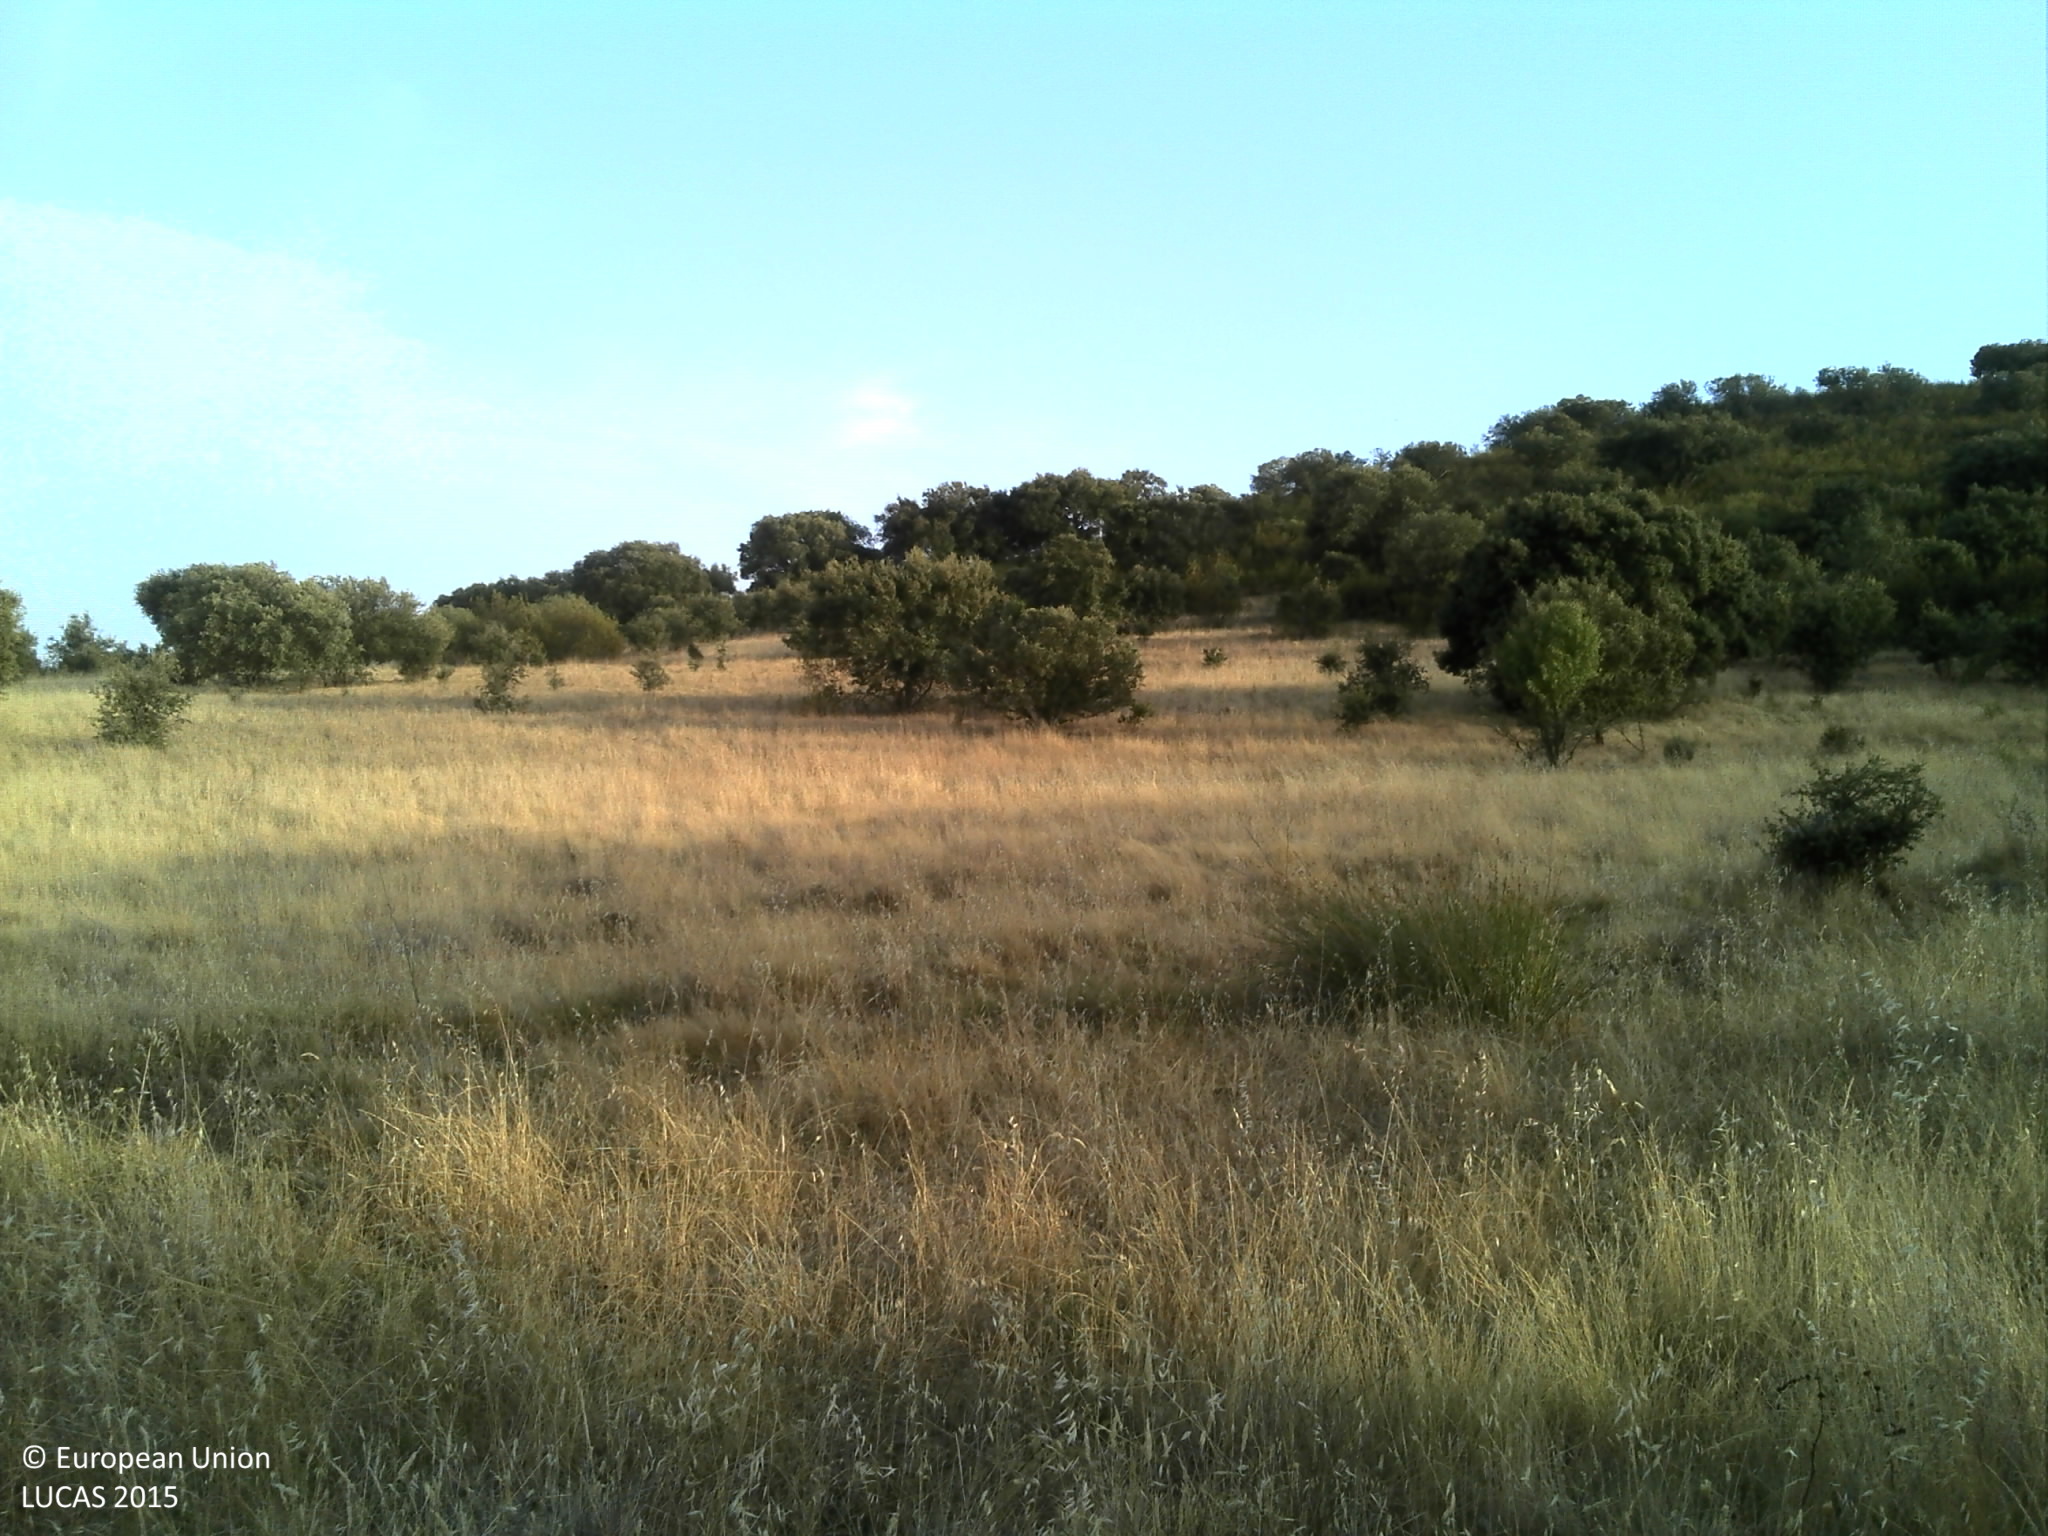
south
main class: Woodland
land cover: Broadleaved woodland
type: broadleaved evergreen forest
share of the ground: 10 - 25 %
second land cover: Grassland without tree/shrub cover
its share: 50 - 75 %
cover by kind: herbaceous plants 65 %, unconsolidated bare surface 20 %, broadleaved forest trees 10 %, shrubs 5 %
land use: Forestry
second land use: Agriculture (excluding fallow land and kitchen gardens)
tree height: < 5 m
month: July
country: PT
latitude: 38.6848
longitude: -7.3764
